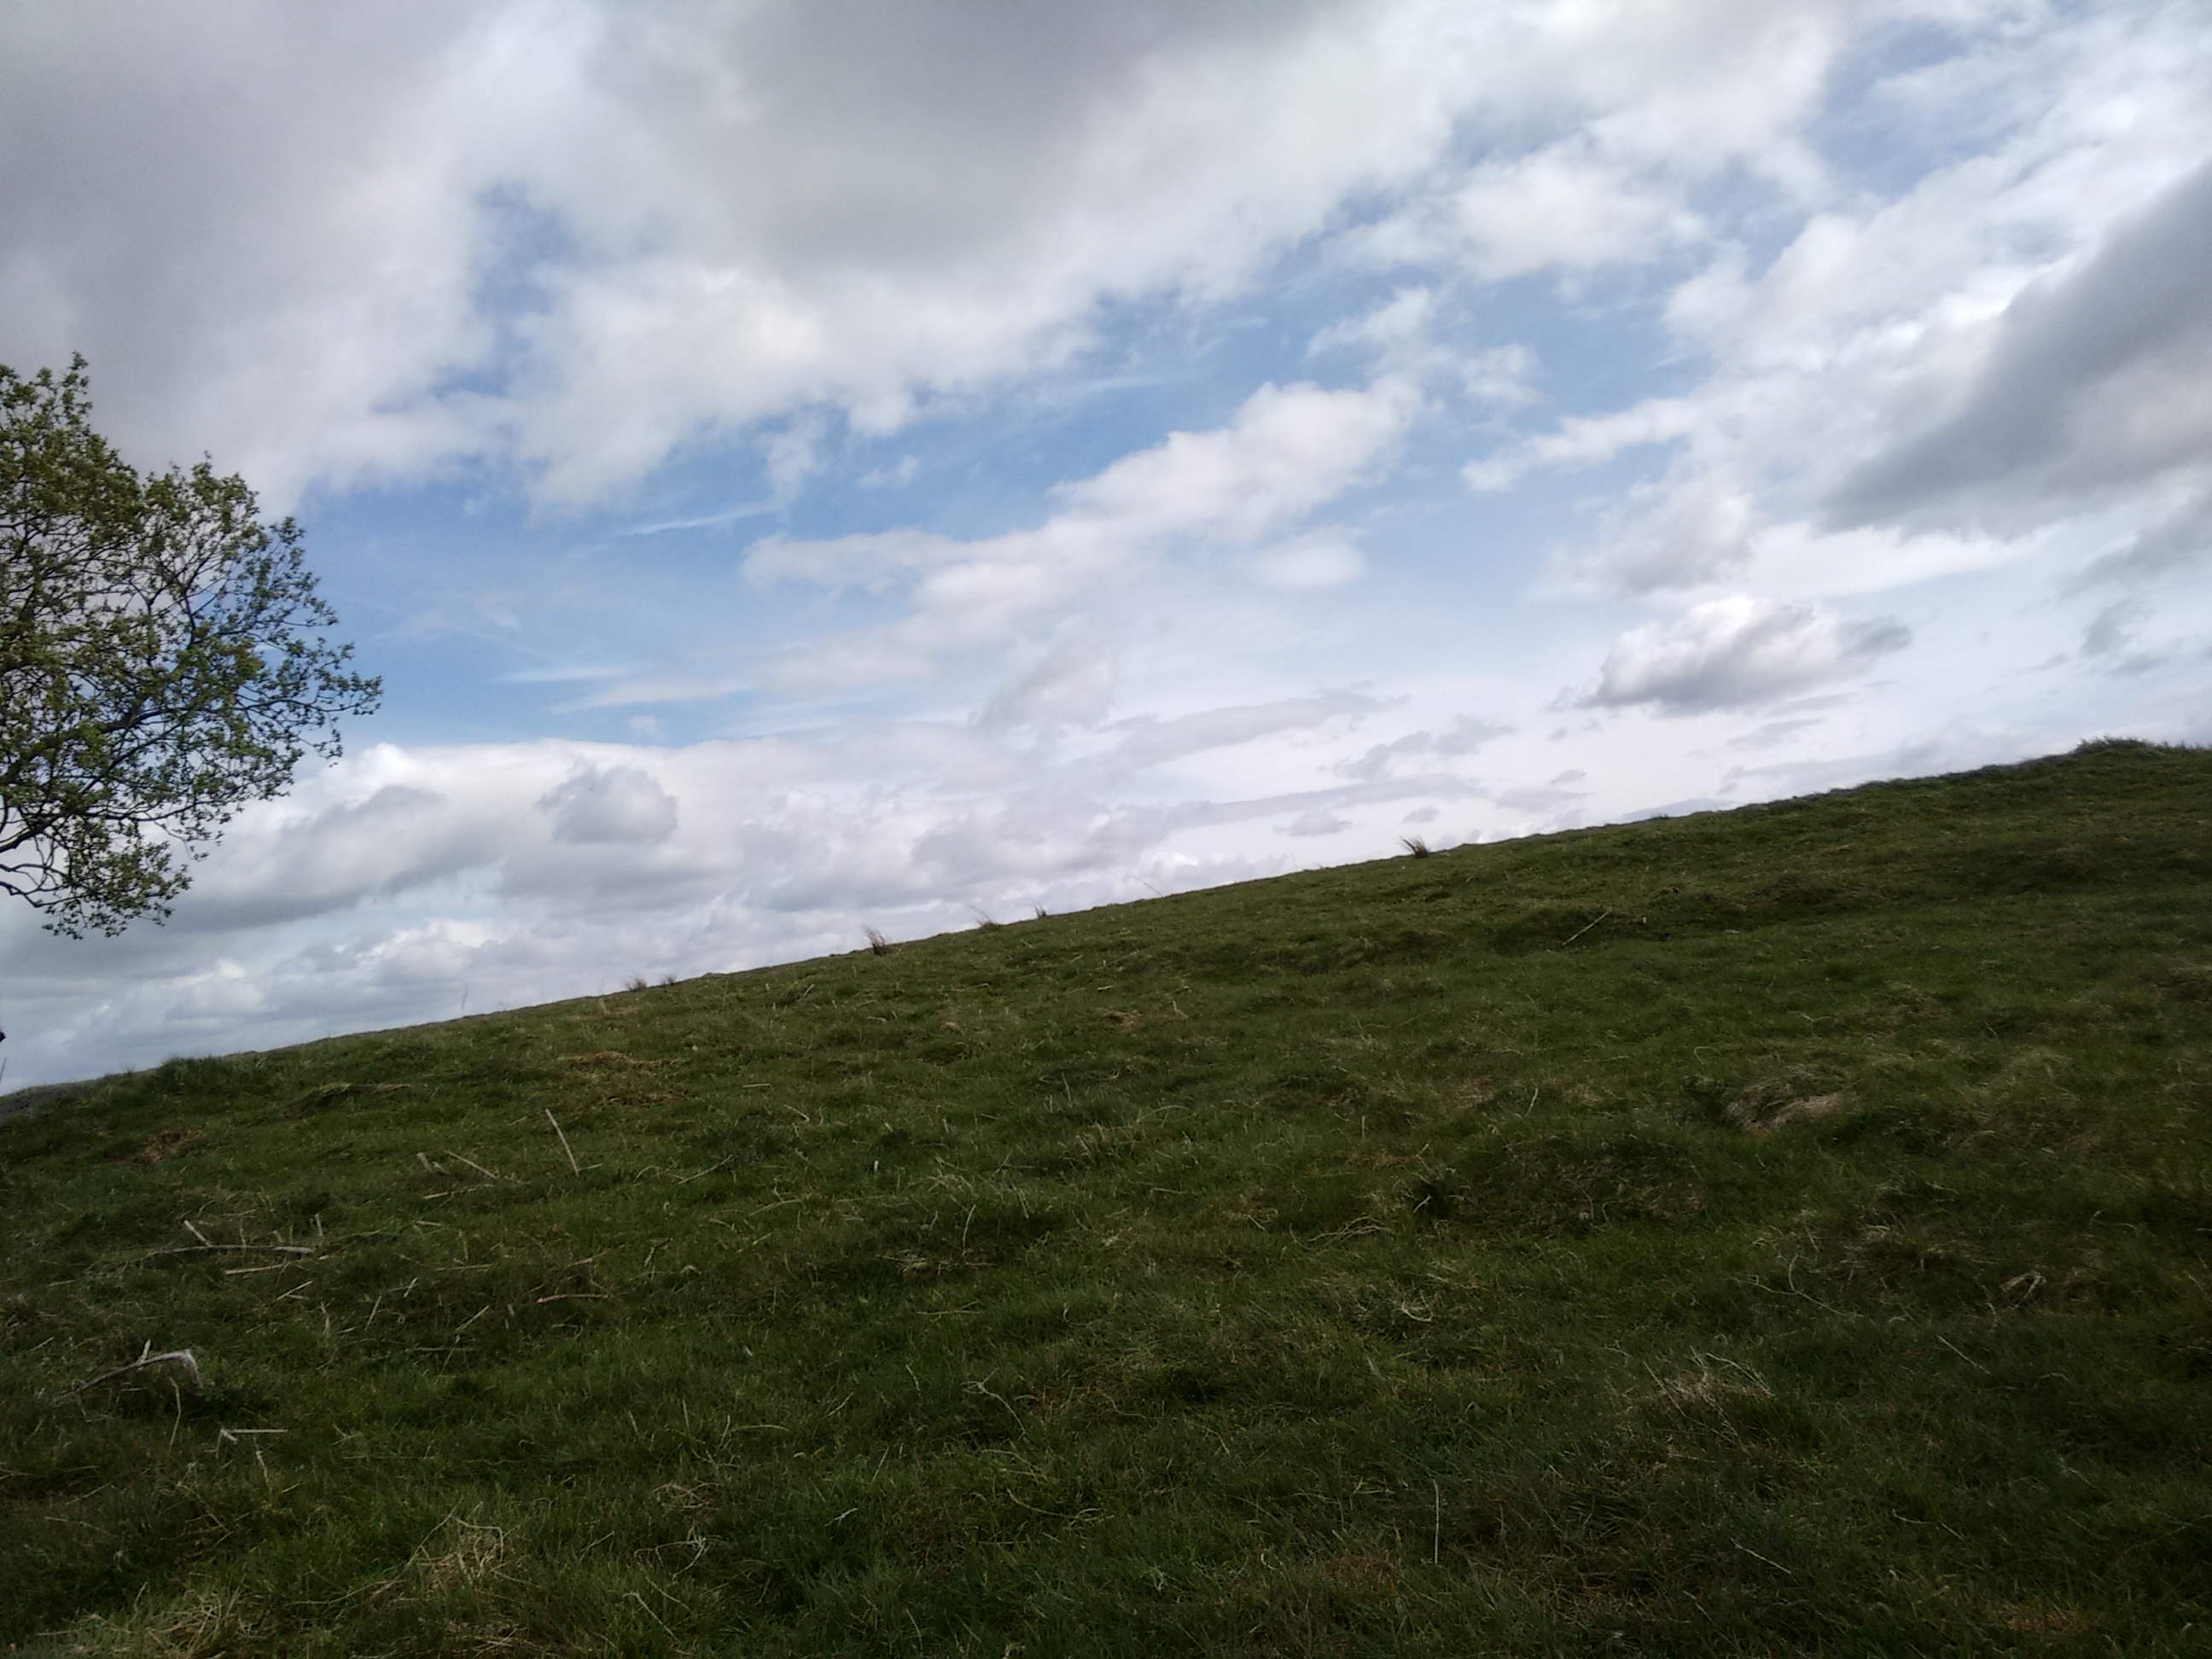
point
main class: Grassland
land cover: Grassland without tree/shrub cover
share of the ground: > 75 %
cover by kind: herbaceous plants 95 %, shrubs 5 %
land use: Agriculture (excluding fallow land and kitchen gardens)
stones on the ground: < 10 %
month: May
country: GB
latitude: 55.8880
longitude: -3.6875
